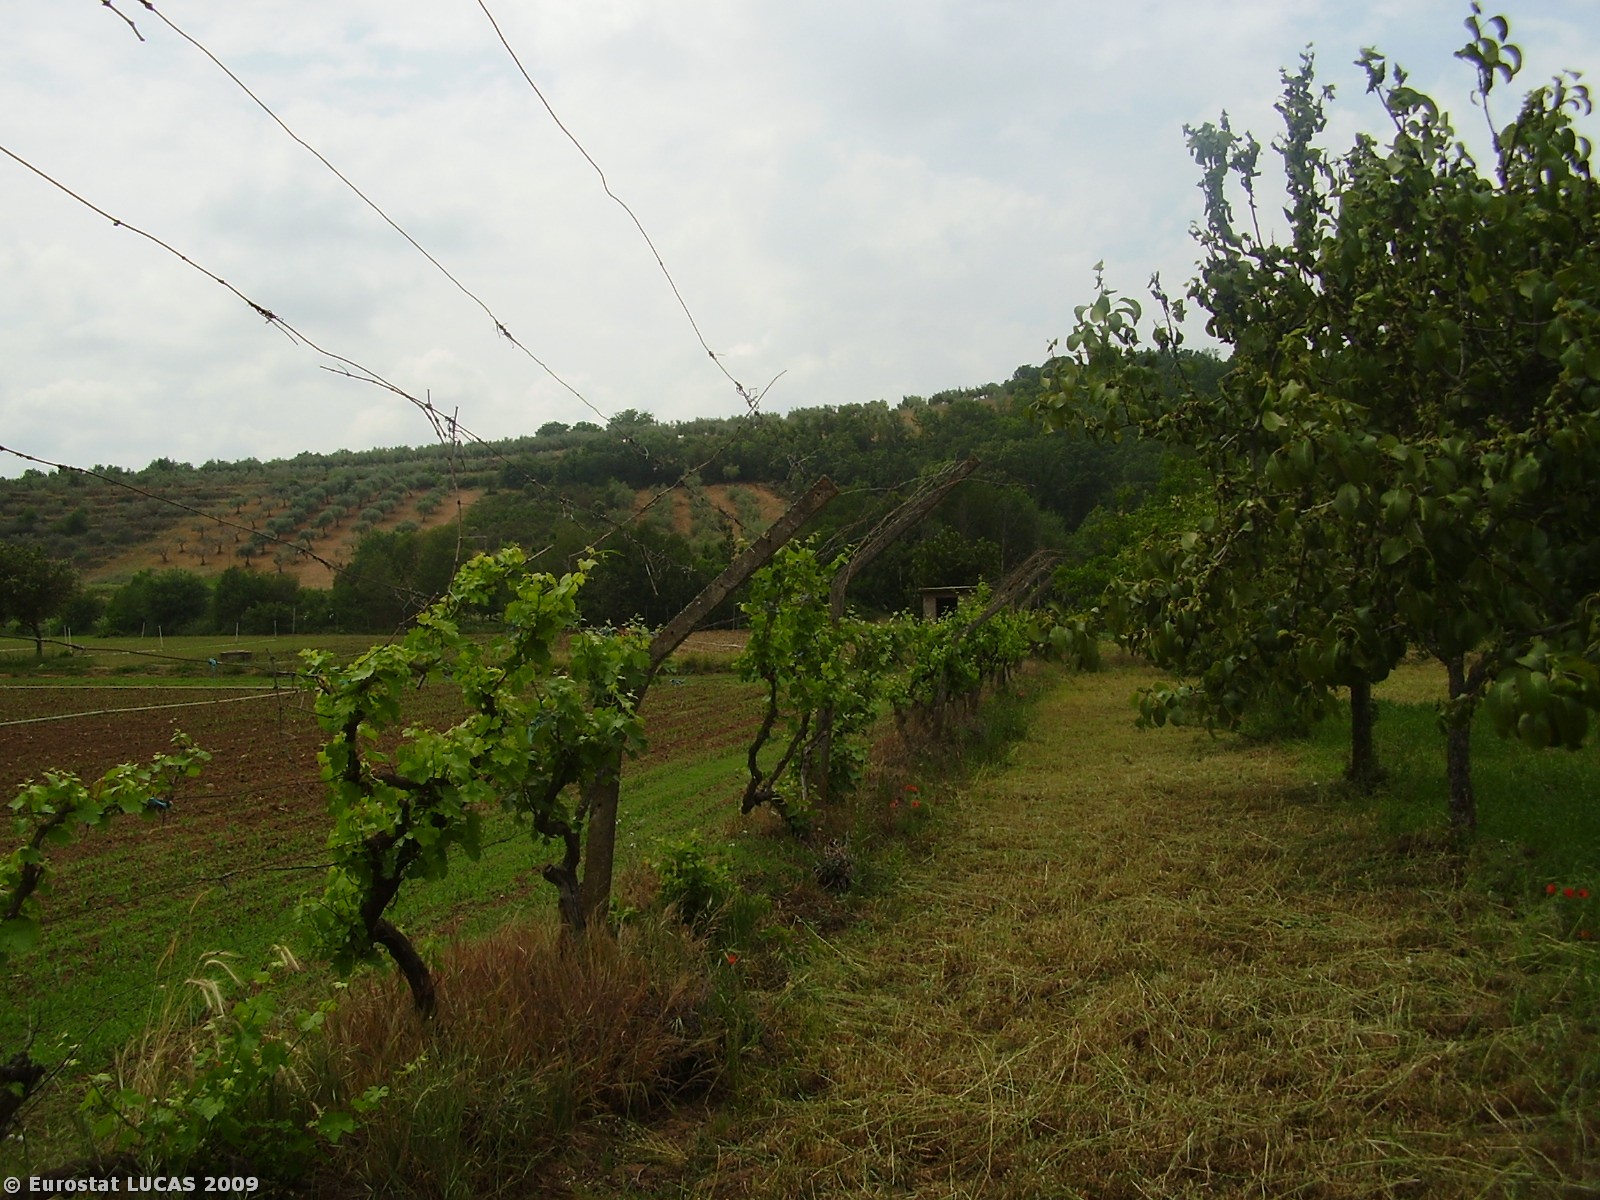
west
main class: Cropland
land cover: Mixed cereals for fodder
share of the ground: > 75 %
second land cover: Pear fruit
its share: < 10 %
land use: Agriculture (excluding fallow land and kitchen gardens)
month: June
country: PT
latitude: 41.5596
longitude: -6.8628
